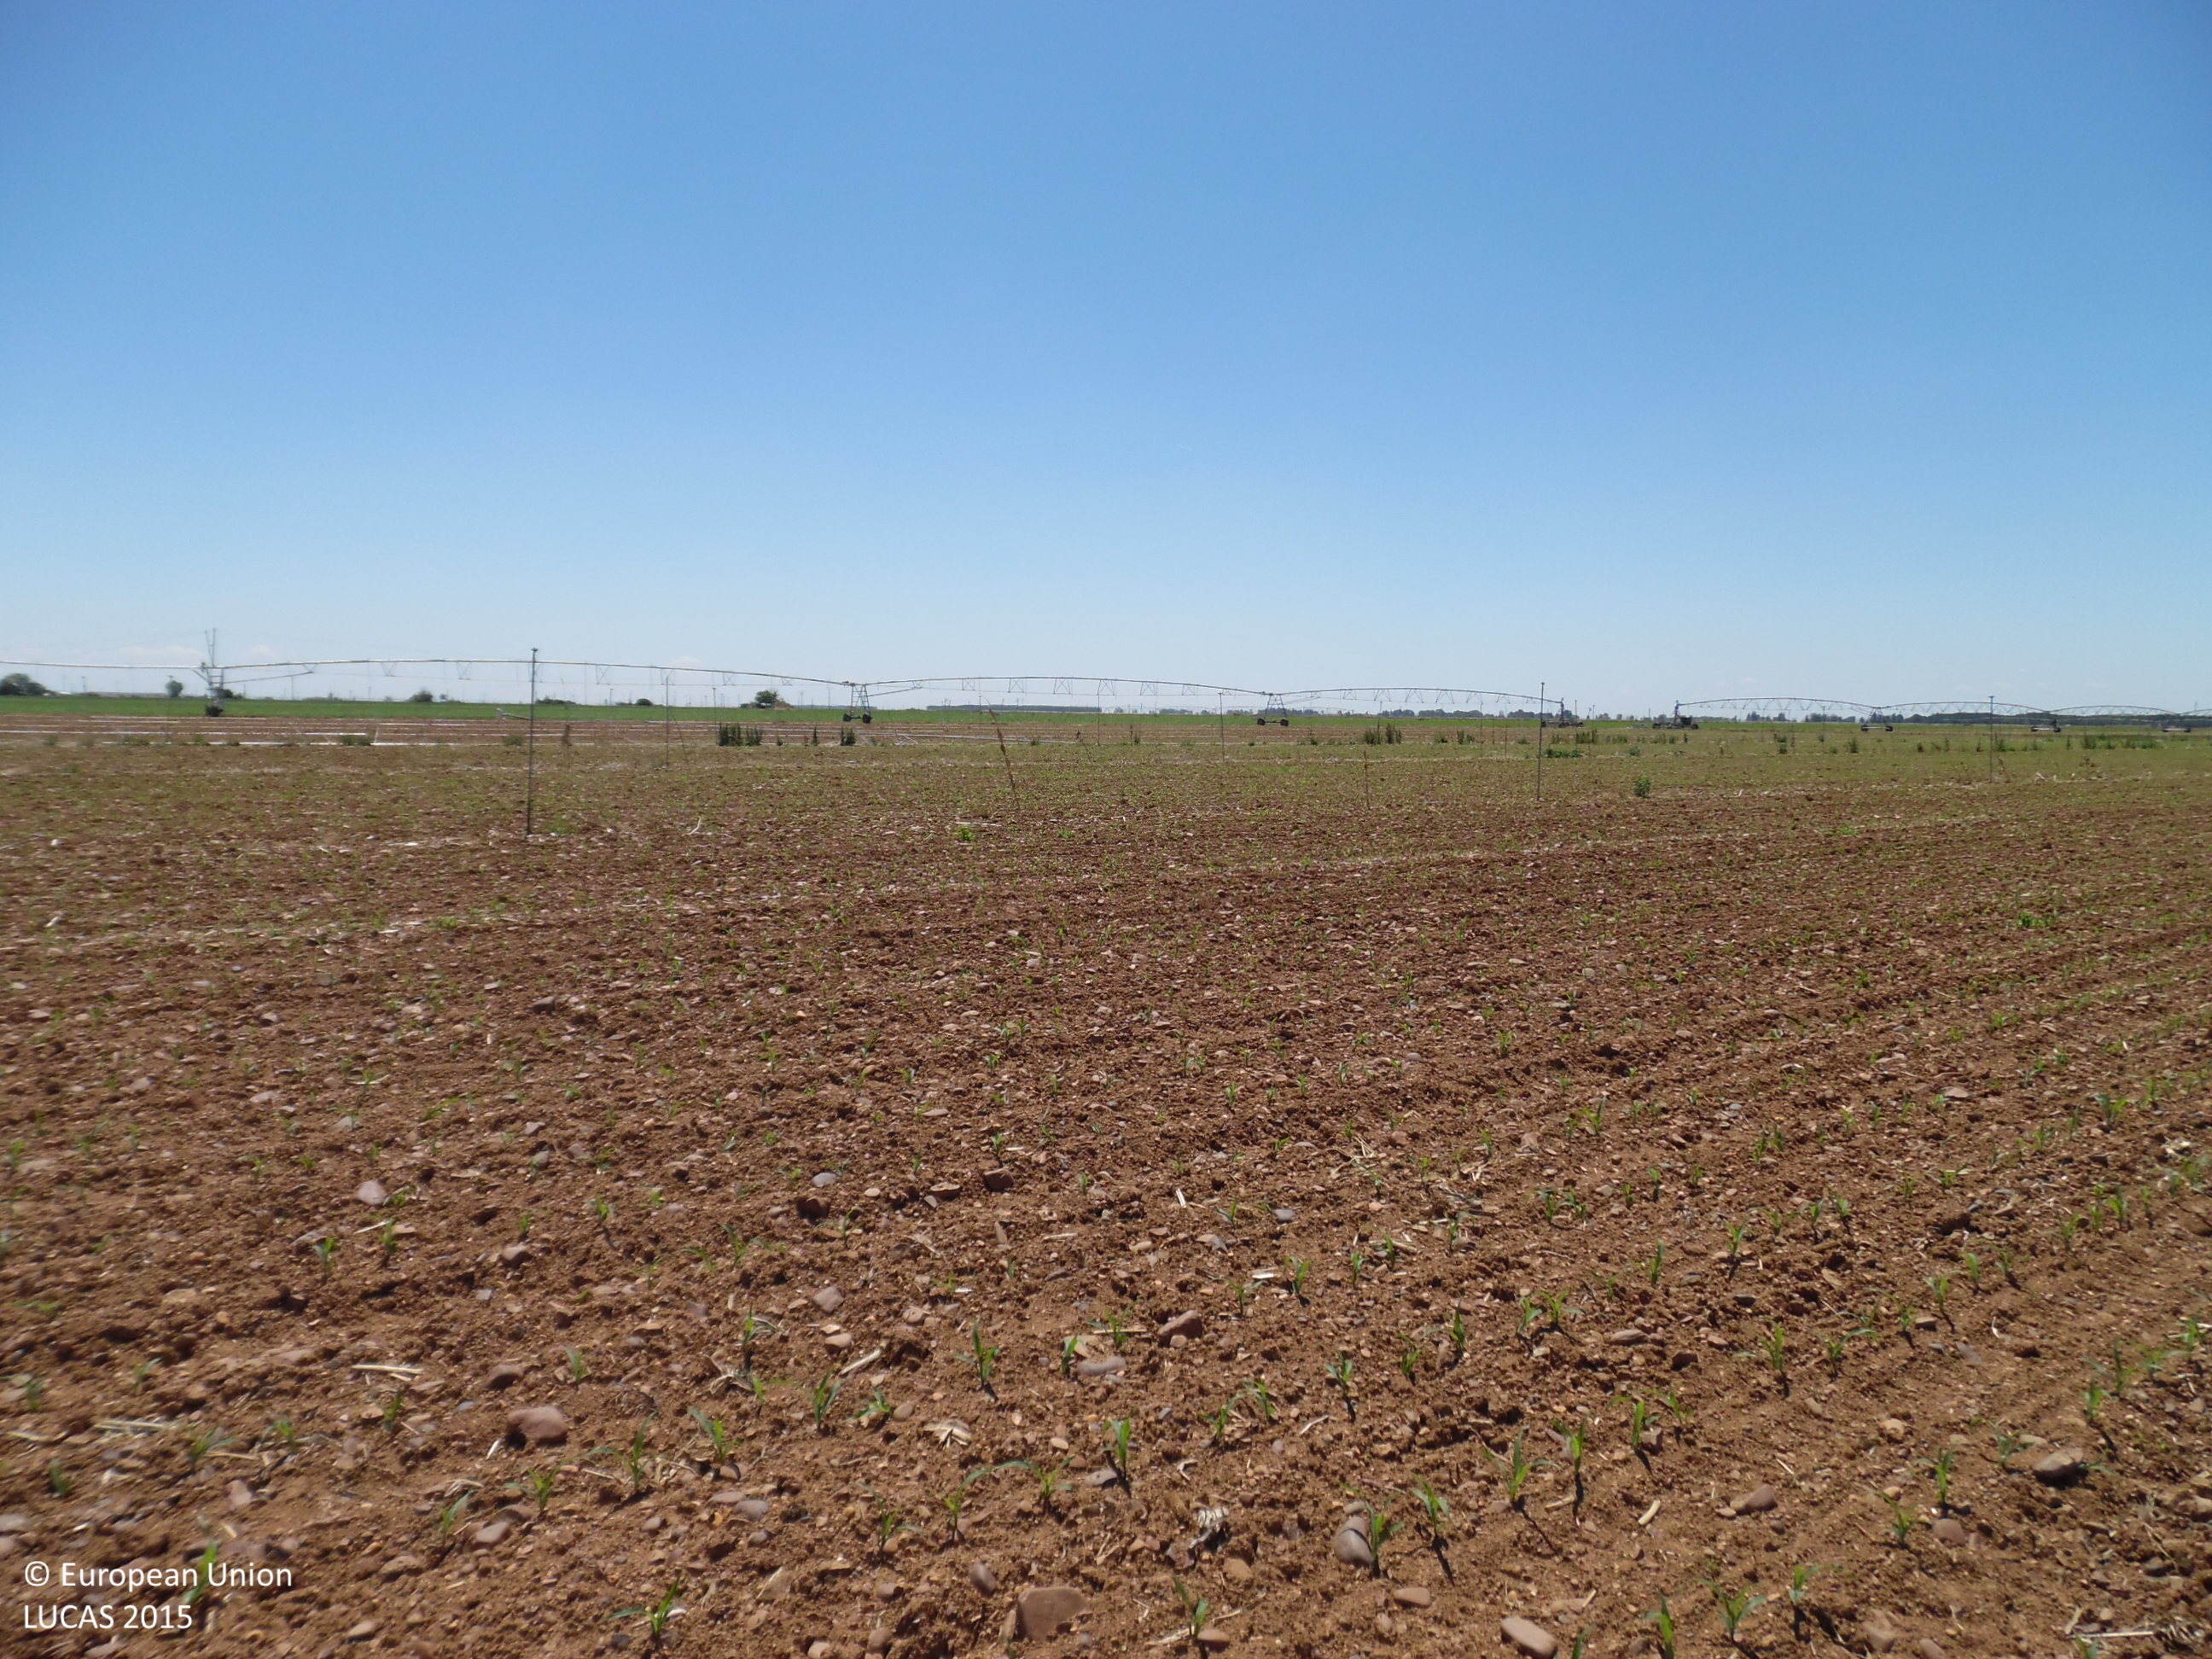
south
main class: Cropland
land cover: Maize
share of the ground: < 10 %
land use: Agriculture (excluding fallow land and kitchen gardens)
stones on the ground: 10 - 25 %
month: June
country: ES
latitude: 42.3965
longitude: -5.6835
